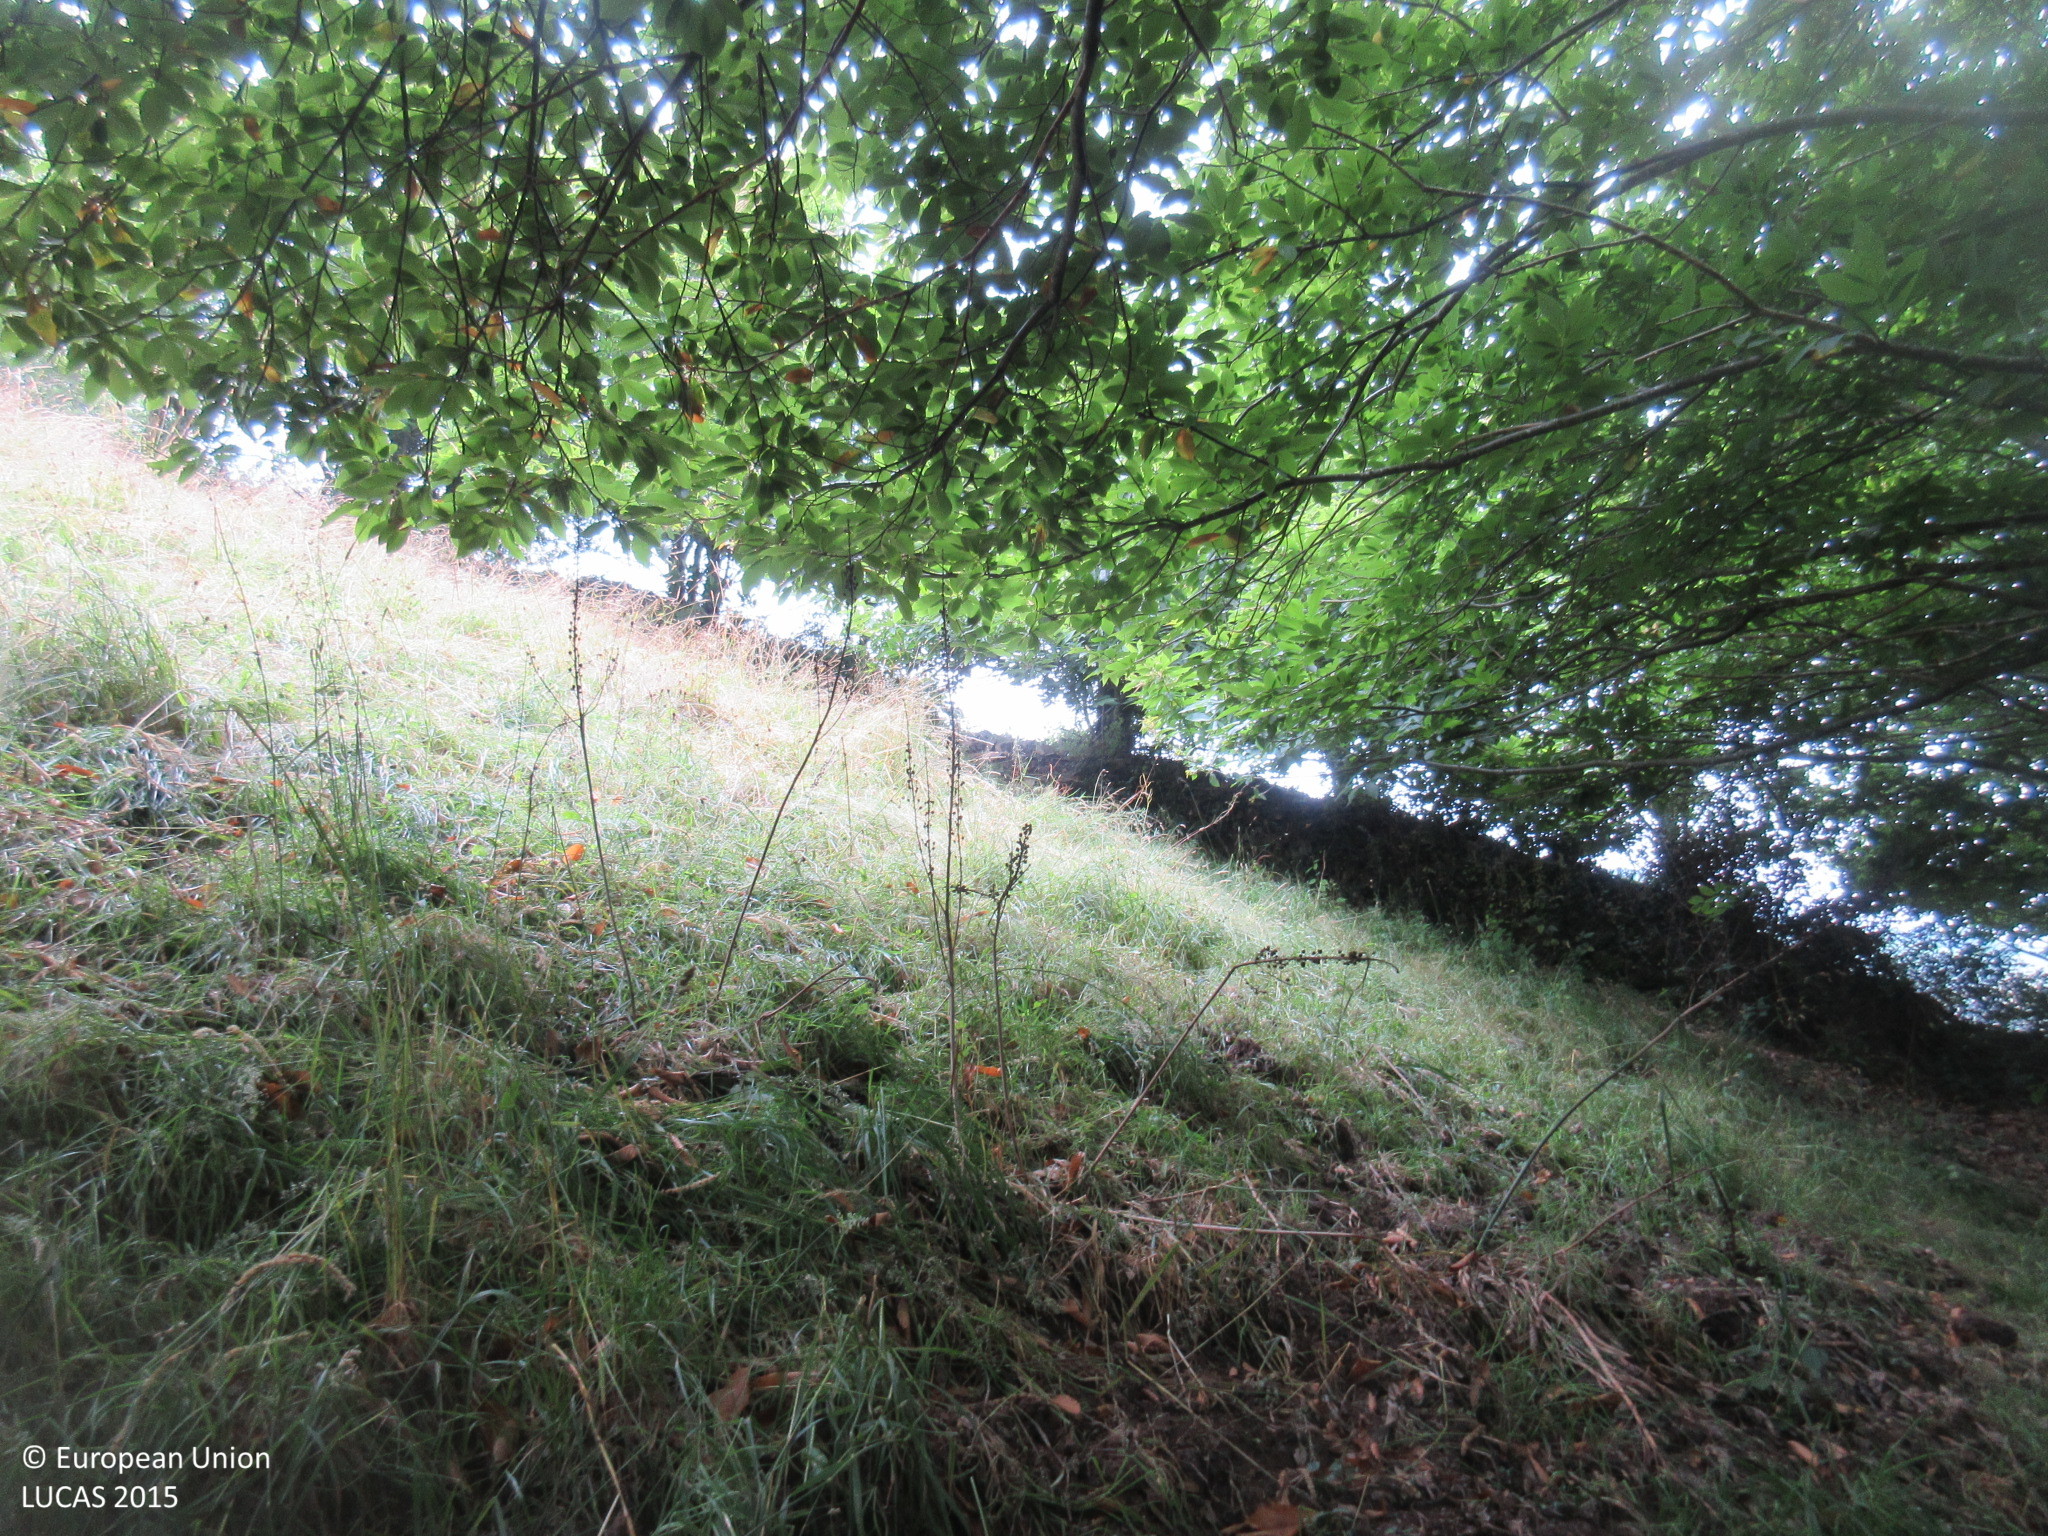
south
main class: Woodland
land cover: Broadleaved woodland
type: thermophilous deciduous forest
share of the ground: > 75 %
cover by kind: broadleaved forest trees 100 %
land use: Forestry
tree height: > 5 m
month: July
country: ES
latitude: 43.4689
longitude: -6.3303
